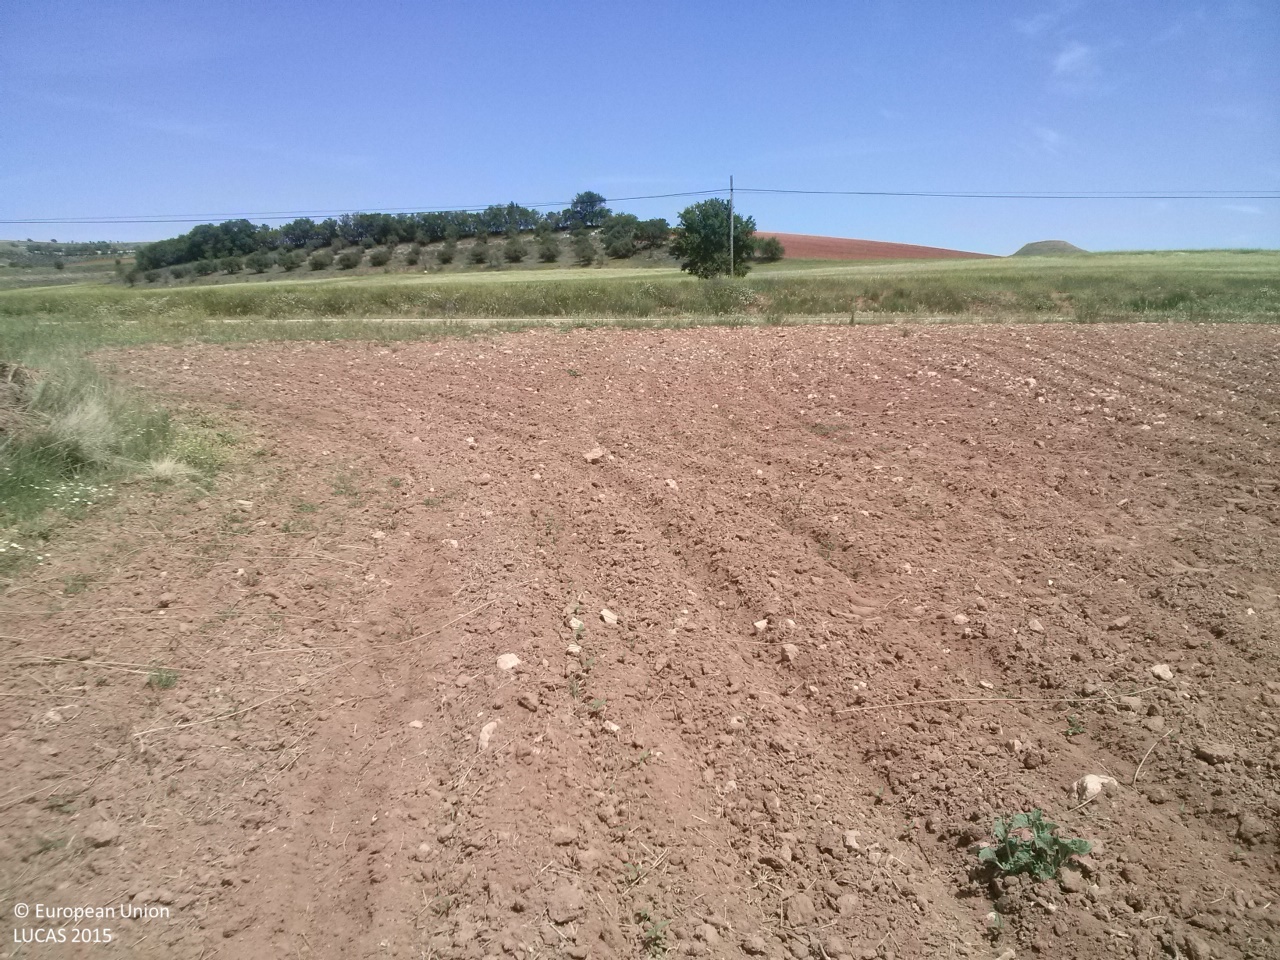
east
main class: Cropland
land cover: Sunflower
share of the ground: < 10 %
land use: Agriculture (excluding fallow land and kitchen gardens)
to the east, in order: Sunflower; Grass margins; Paved roads, cycling and walking lanes; Grass margins; Barley; Electric lines; Single bushes/trees; Barley; Grassland with sparse tree/shrub cover; Sunflower
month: May
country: ES
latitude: 40.0432
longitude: -2.6908
